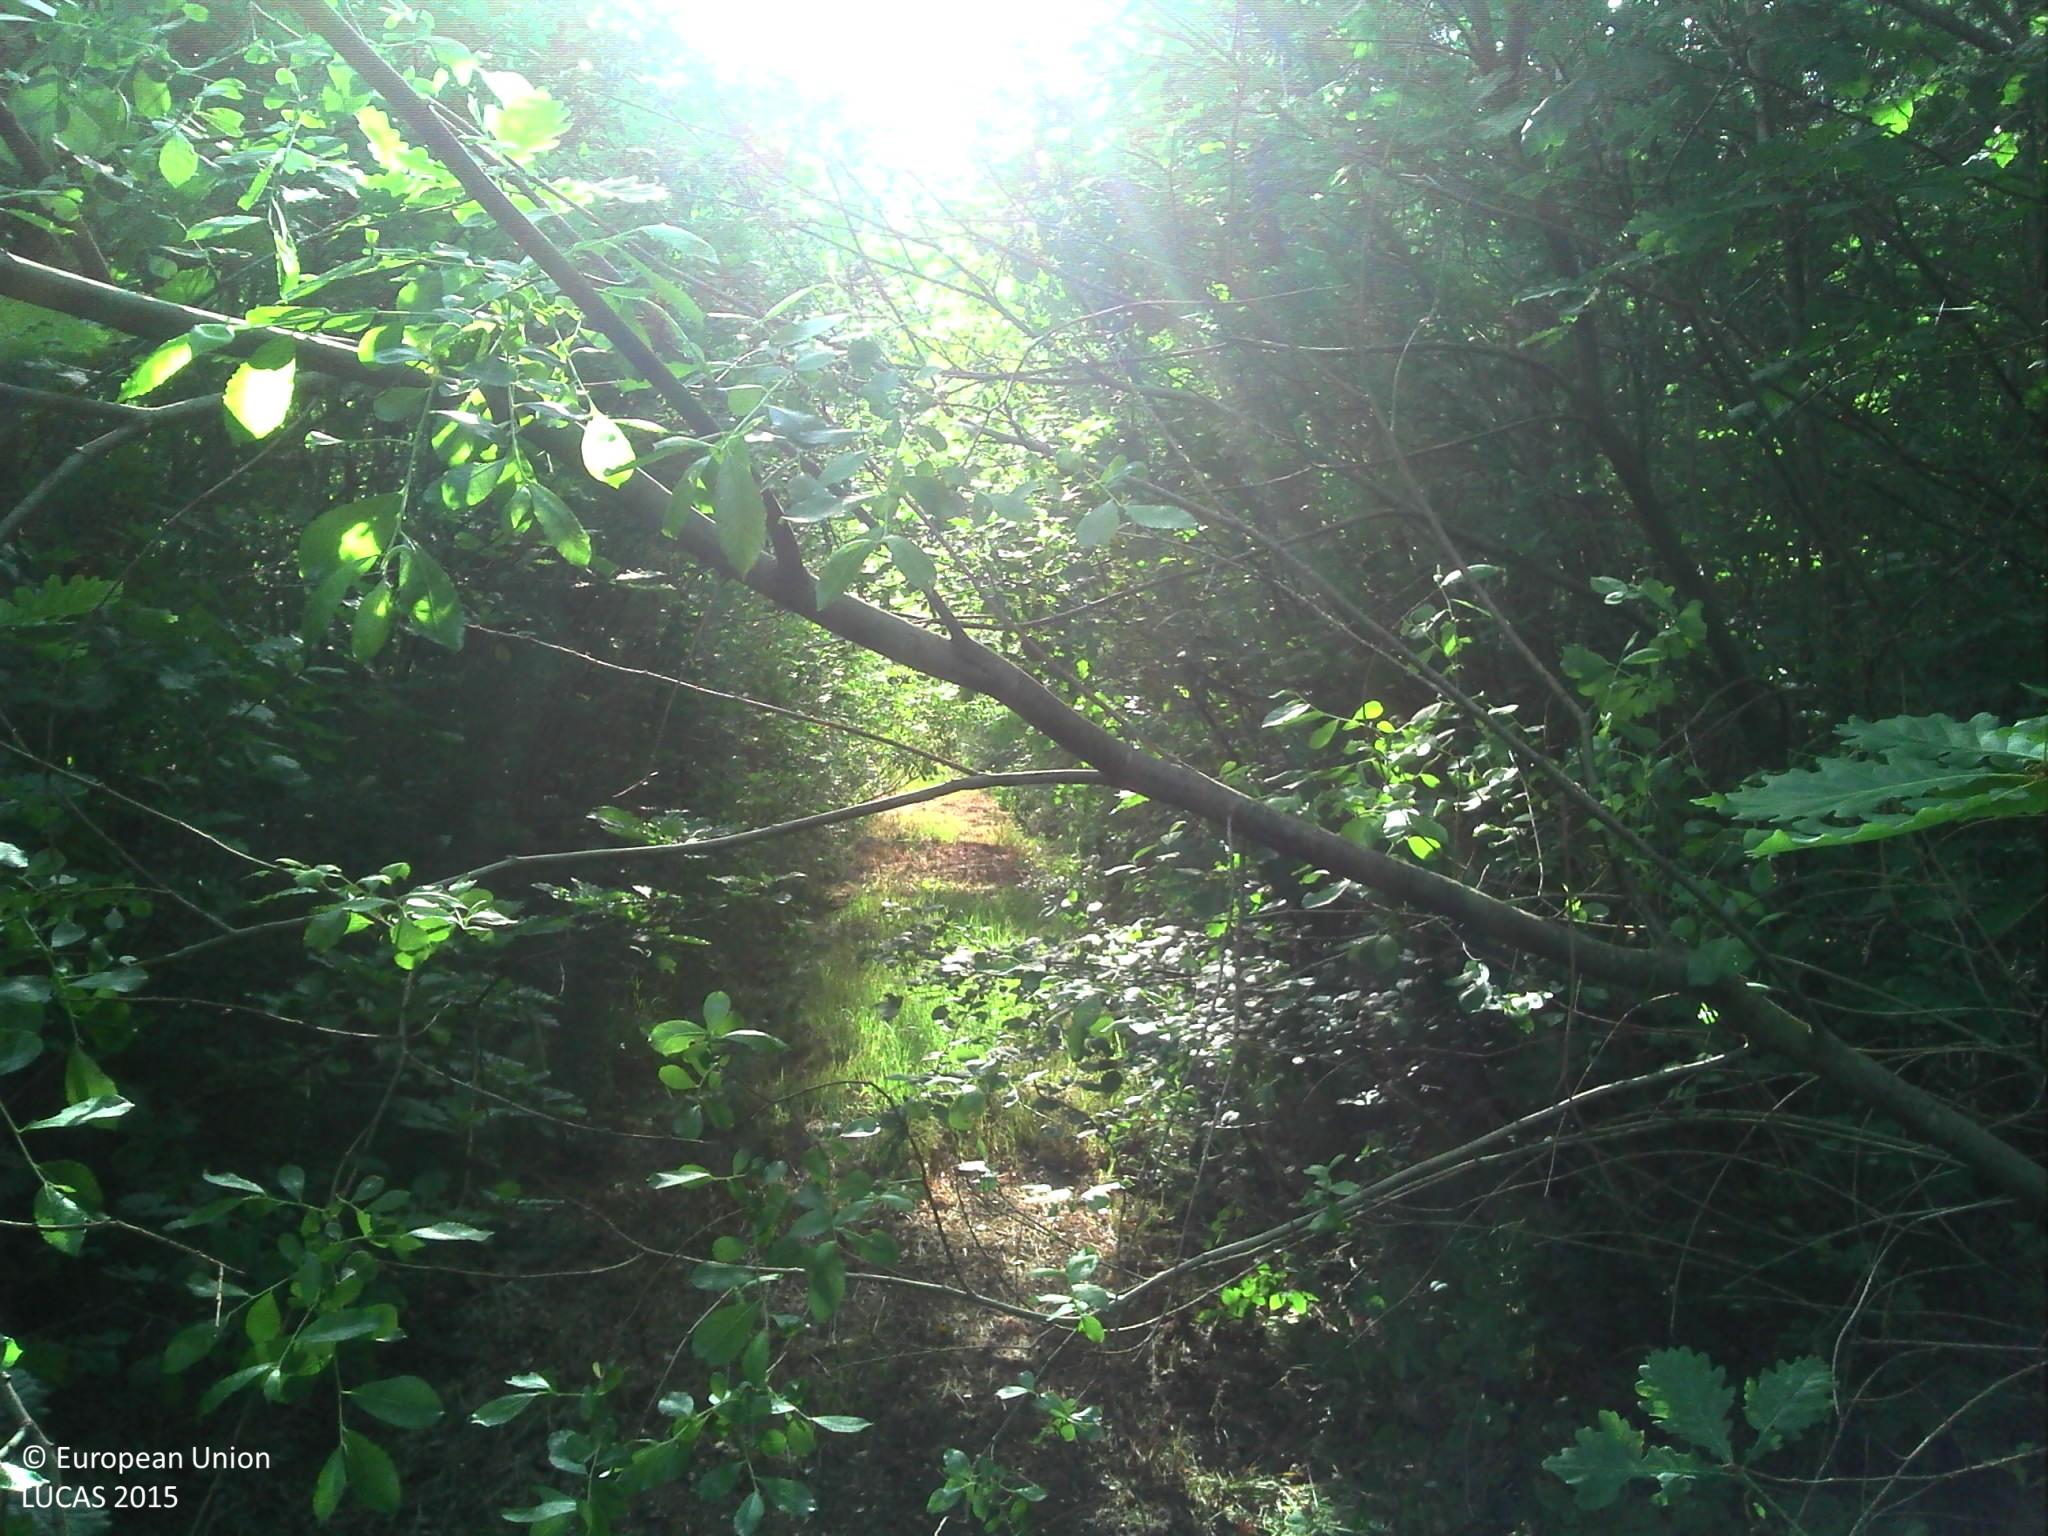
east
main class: Woodland
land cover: Broadleaved woodland
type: mesophytic deciduous forest
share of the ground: > 75 %
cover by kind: broadleaved forest trees 95 %, herbaceous plants 5 %
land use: Forestry
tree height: < 5 m
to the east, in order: Tracks; Broadleaved woodland; Ditches and canals; Grass margins; Tracks; Grass margins; Ditches and canals; Broadleaved woodland
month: June
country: FR
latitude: 47.5602
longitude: 1.3863
